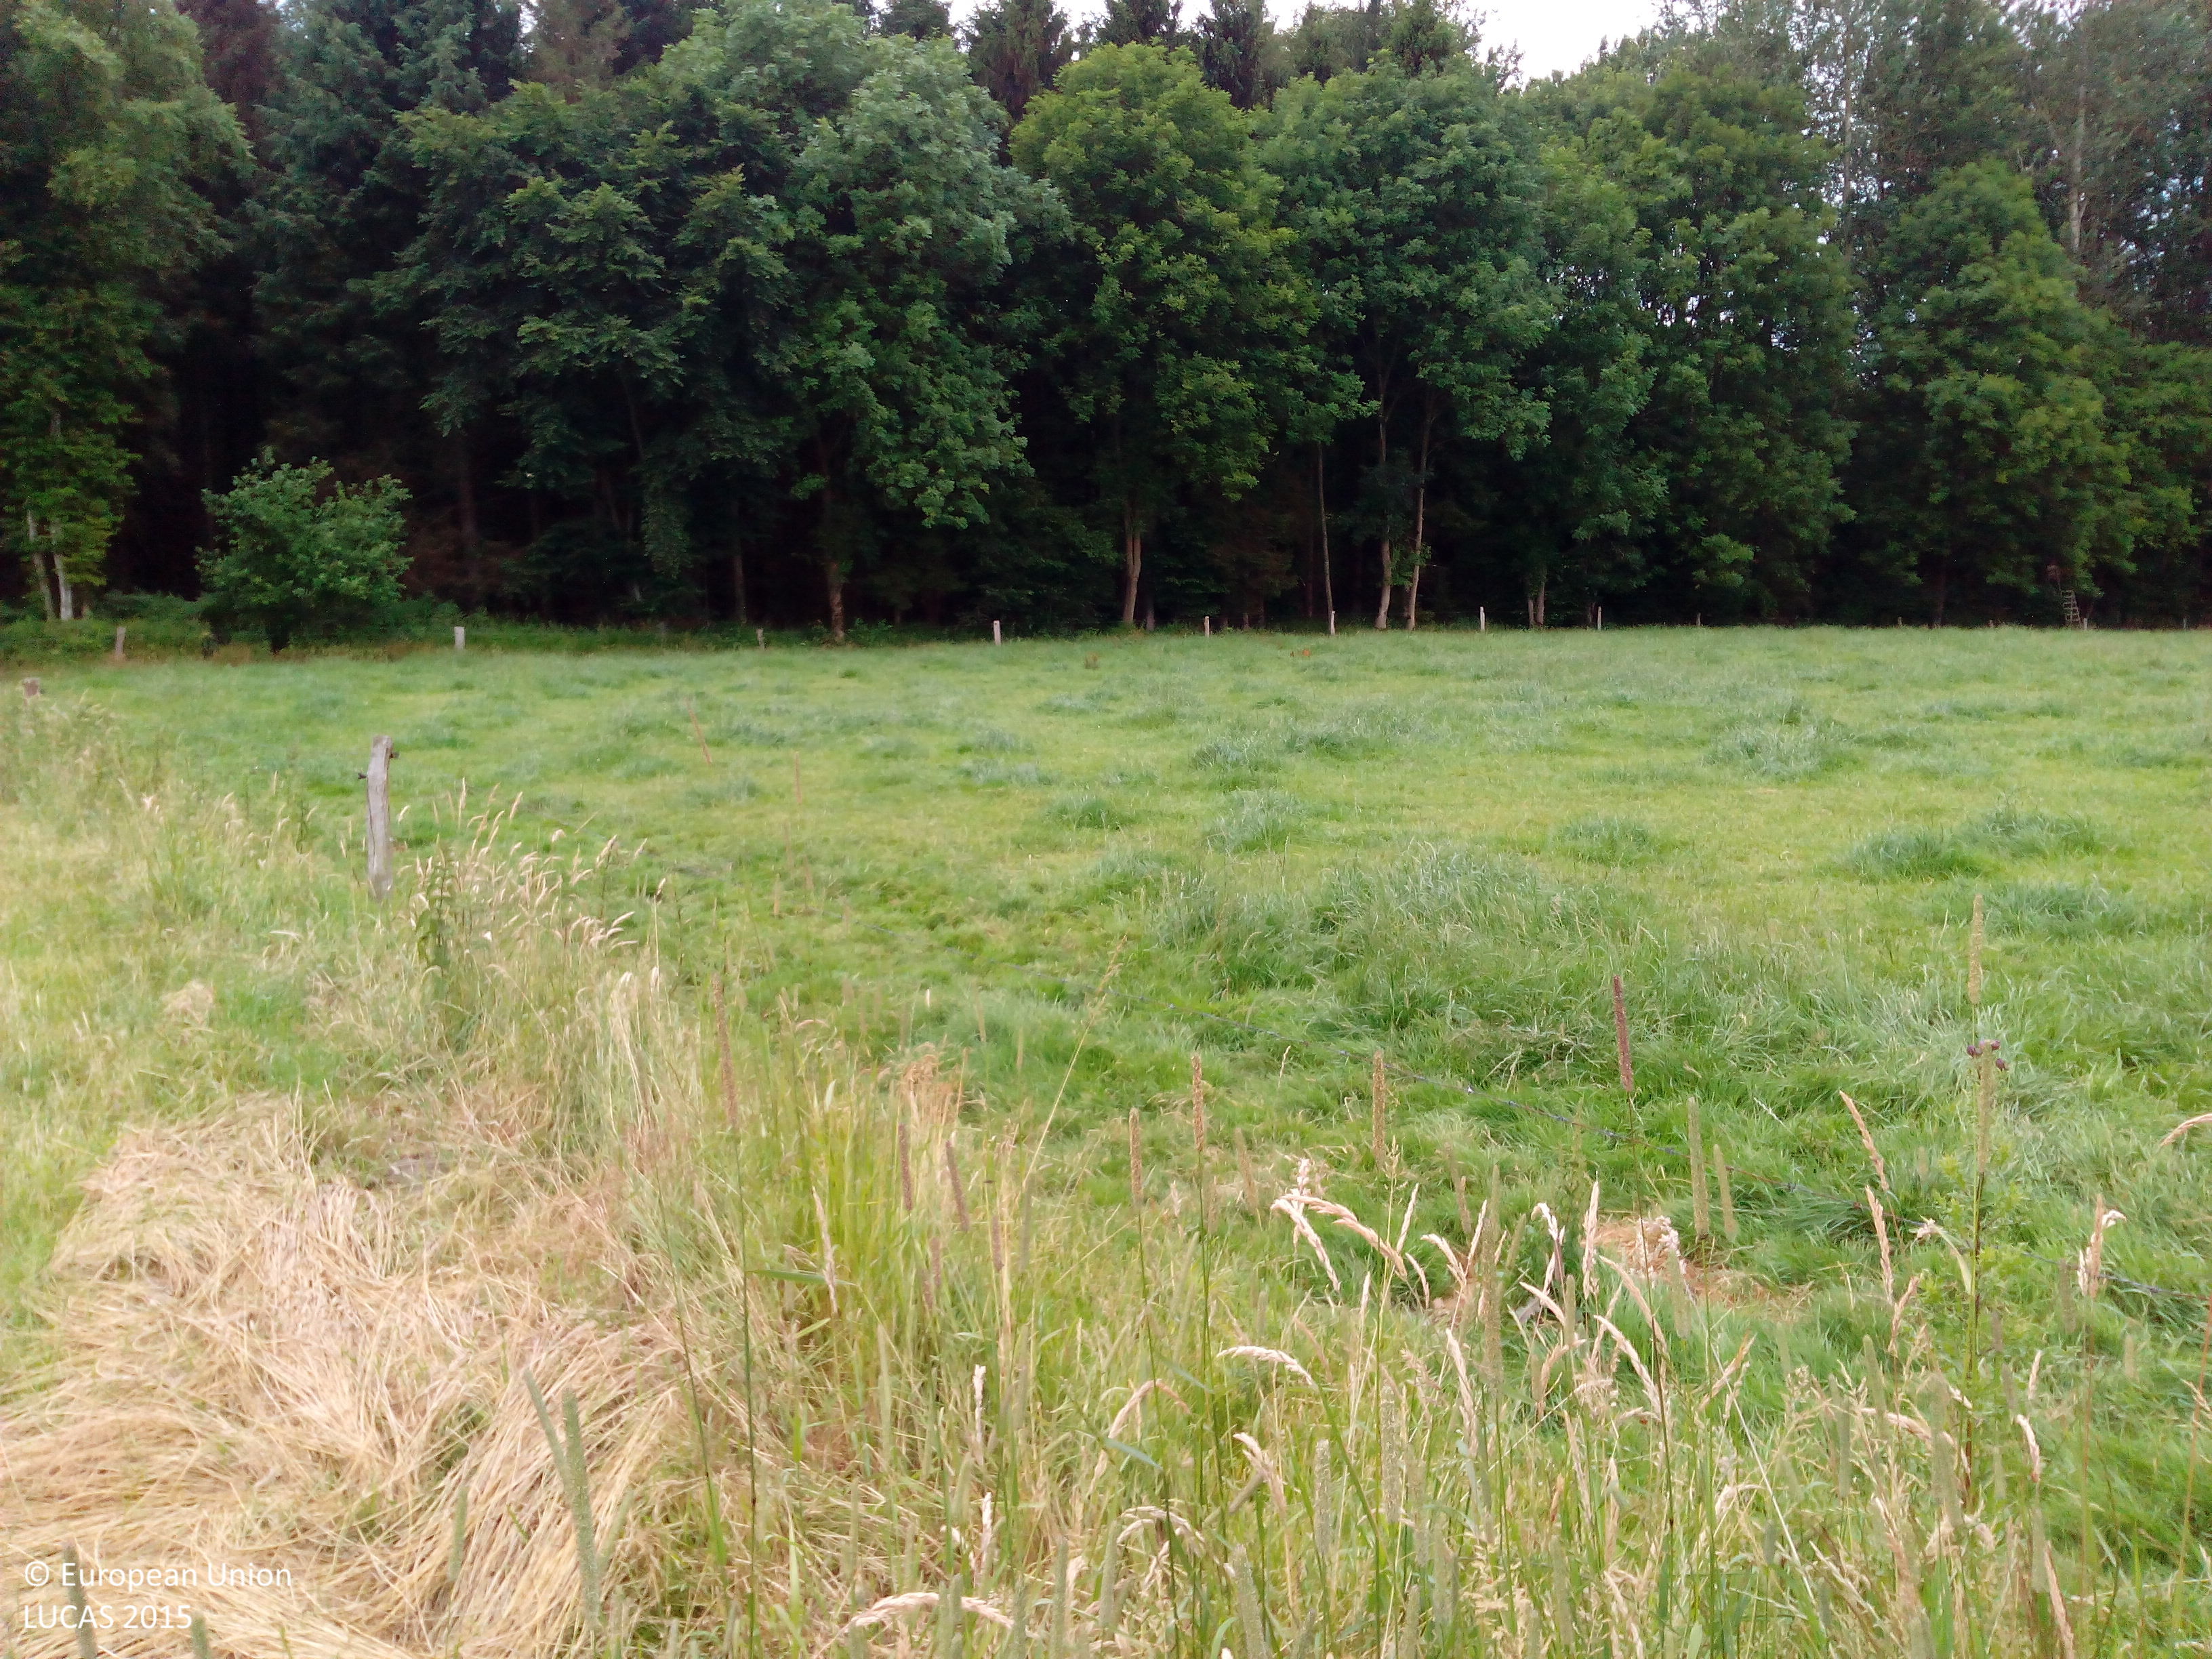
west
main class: Grassland
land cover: Grassland without tree/shrub cover
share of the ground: > 75 %
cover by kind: herbaceous plants 100 %
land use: Agriculture (excluding fallow land and kitchen gardens)
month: July
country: DE
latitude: 53.3126
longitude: 7.9444
